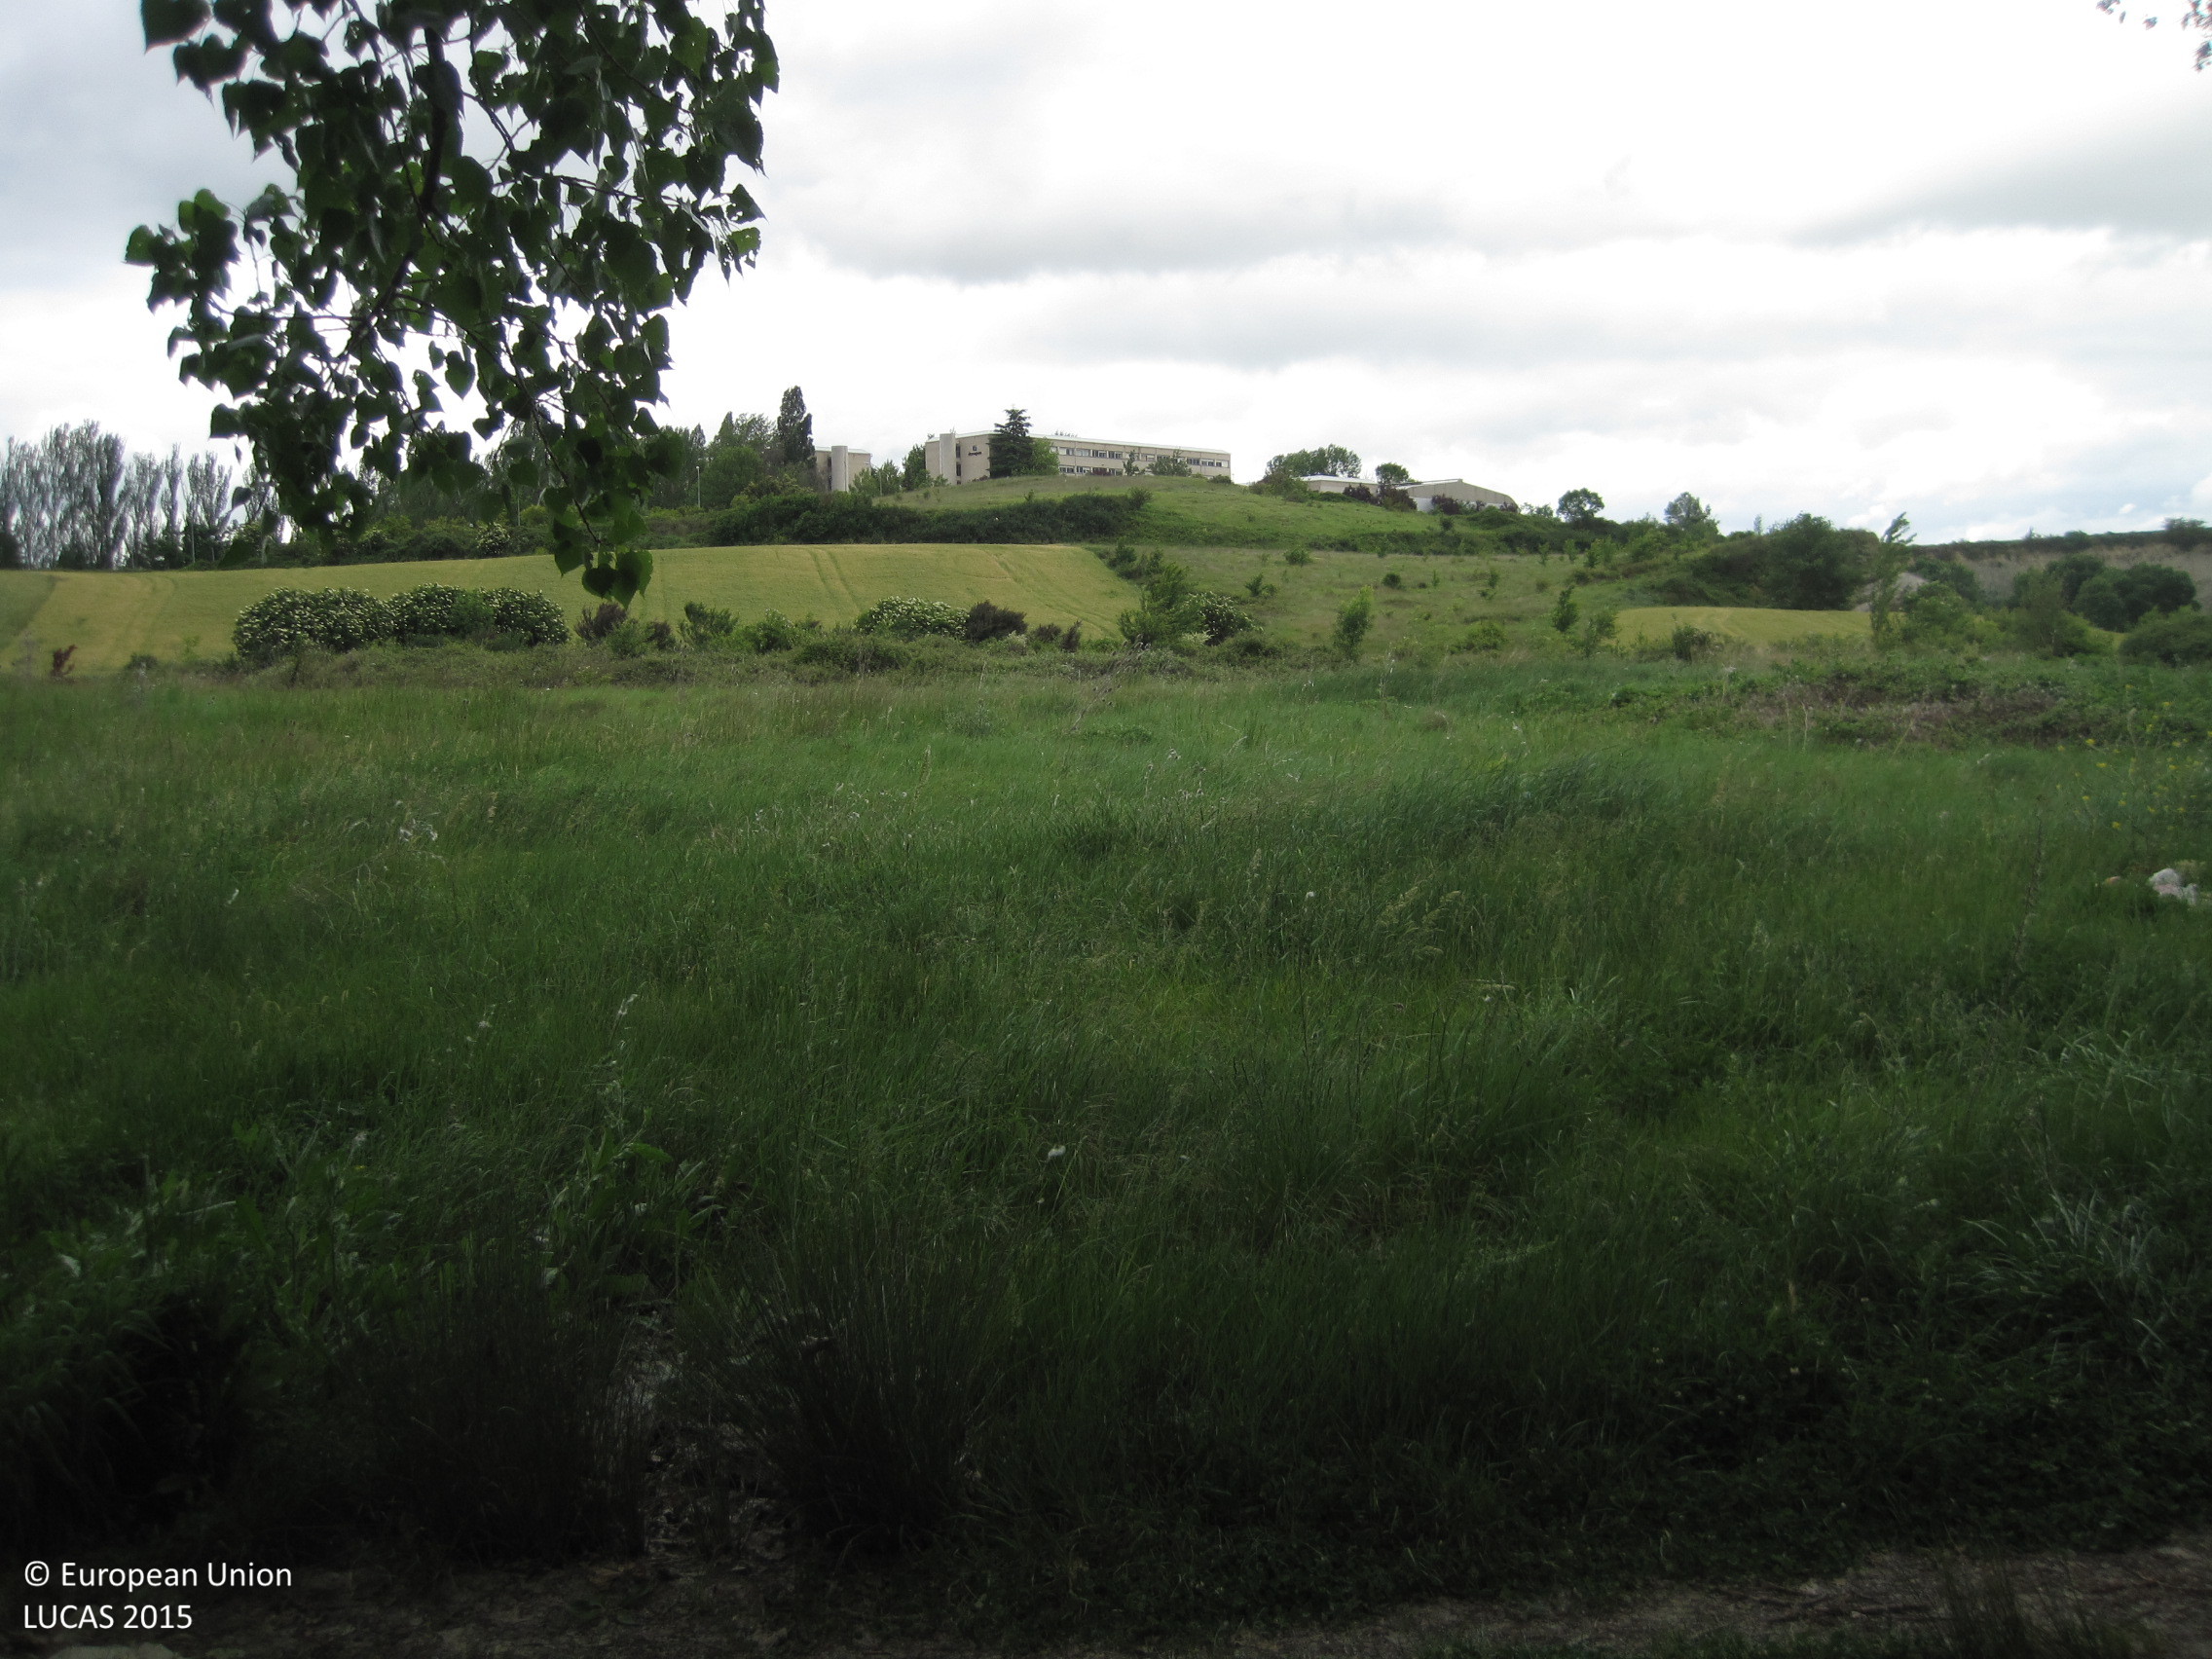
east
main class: Woodland
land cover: Broadleaved woodland
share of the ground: > 75 %
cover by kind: broadleaved forest trees 100 %
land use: Semi-natural and natural areas not in use
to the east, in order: Broadleaved woodland; Tracks; Spontaneously vegetated surfaces; Barley; Spontaneously vegetated surfaces
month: May
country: ES
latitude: 42.7975
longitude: -1.6667
